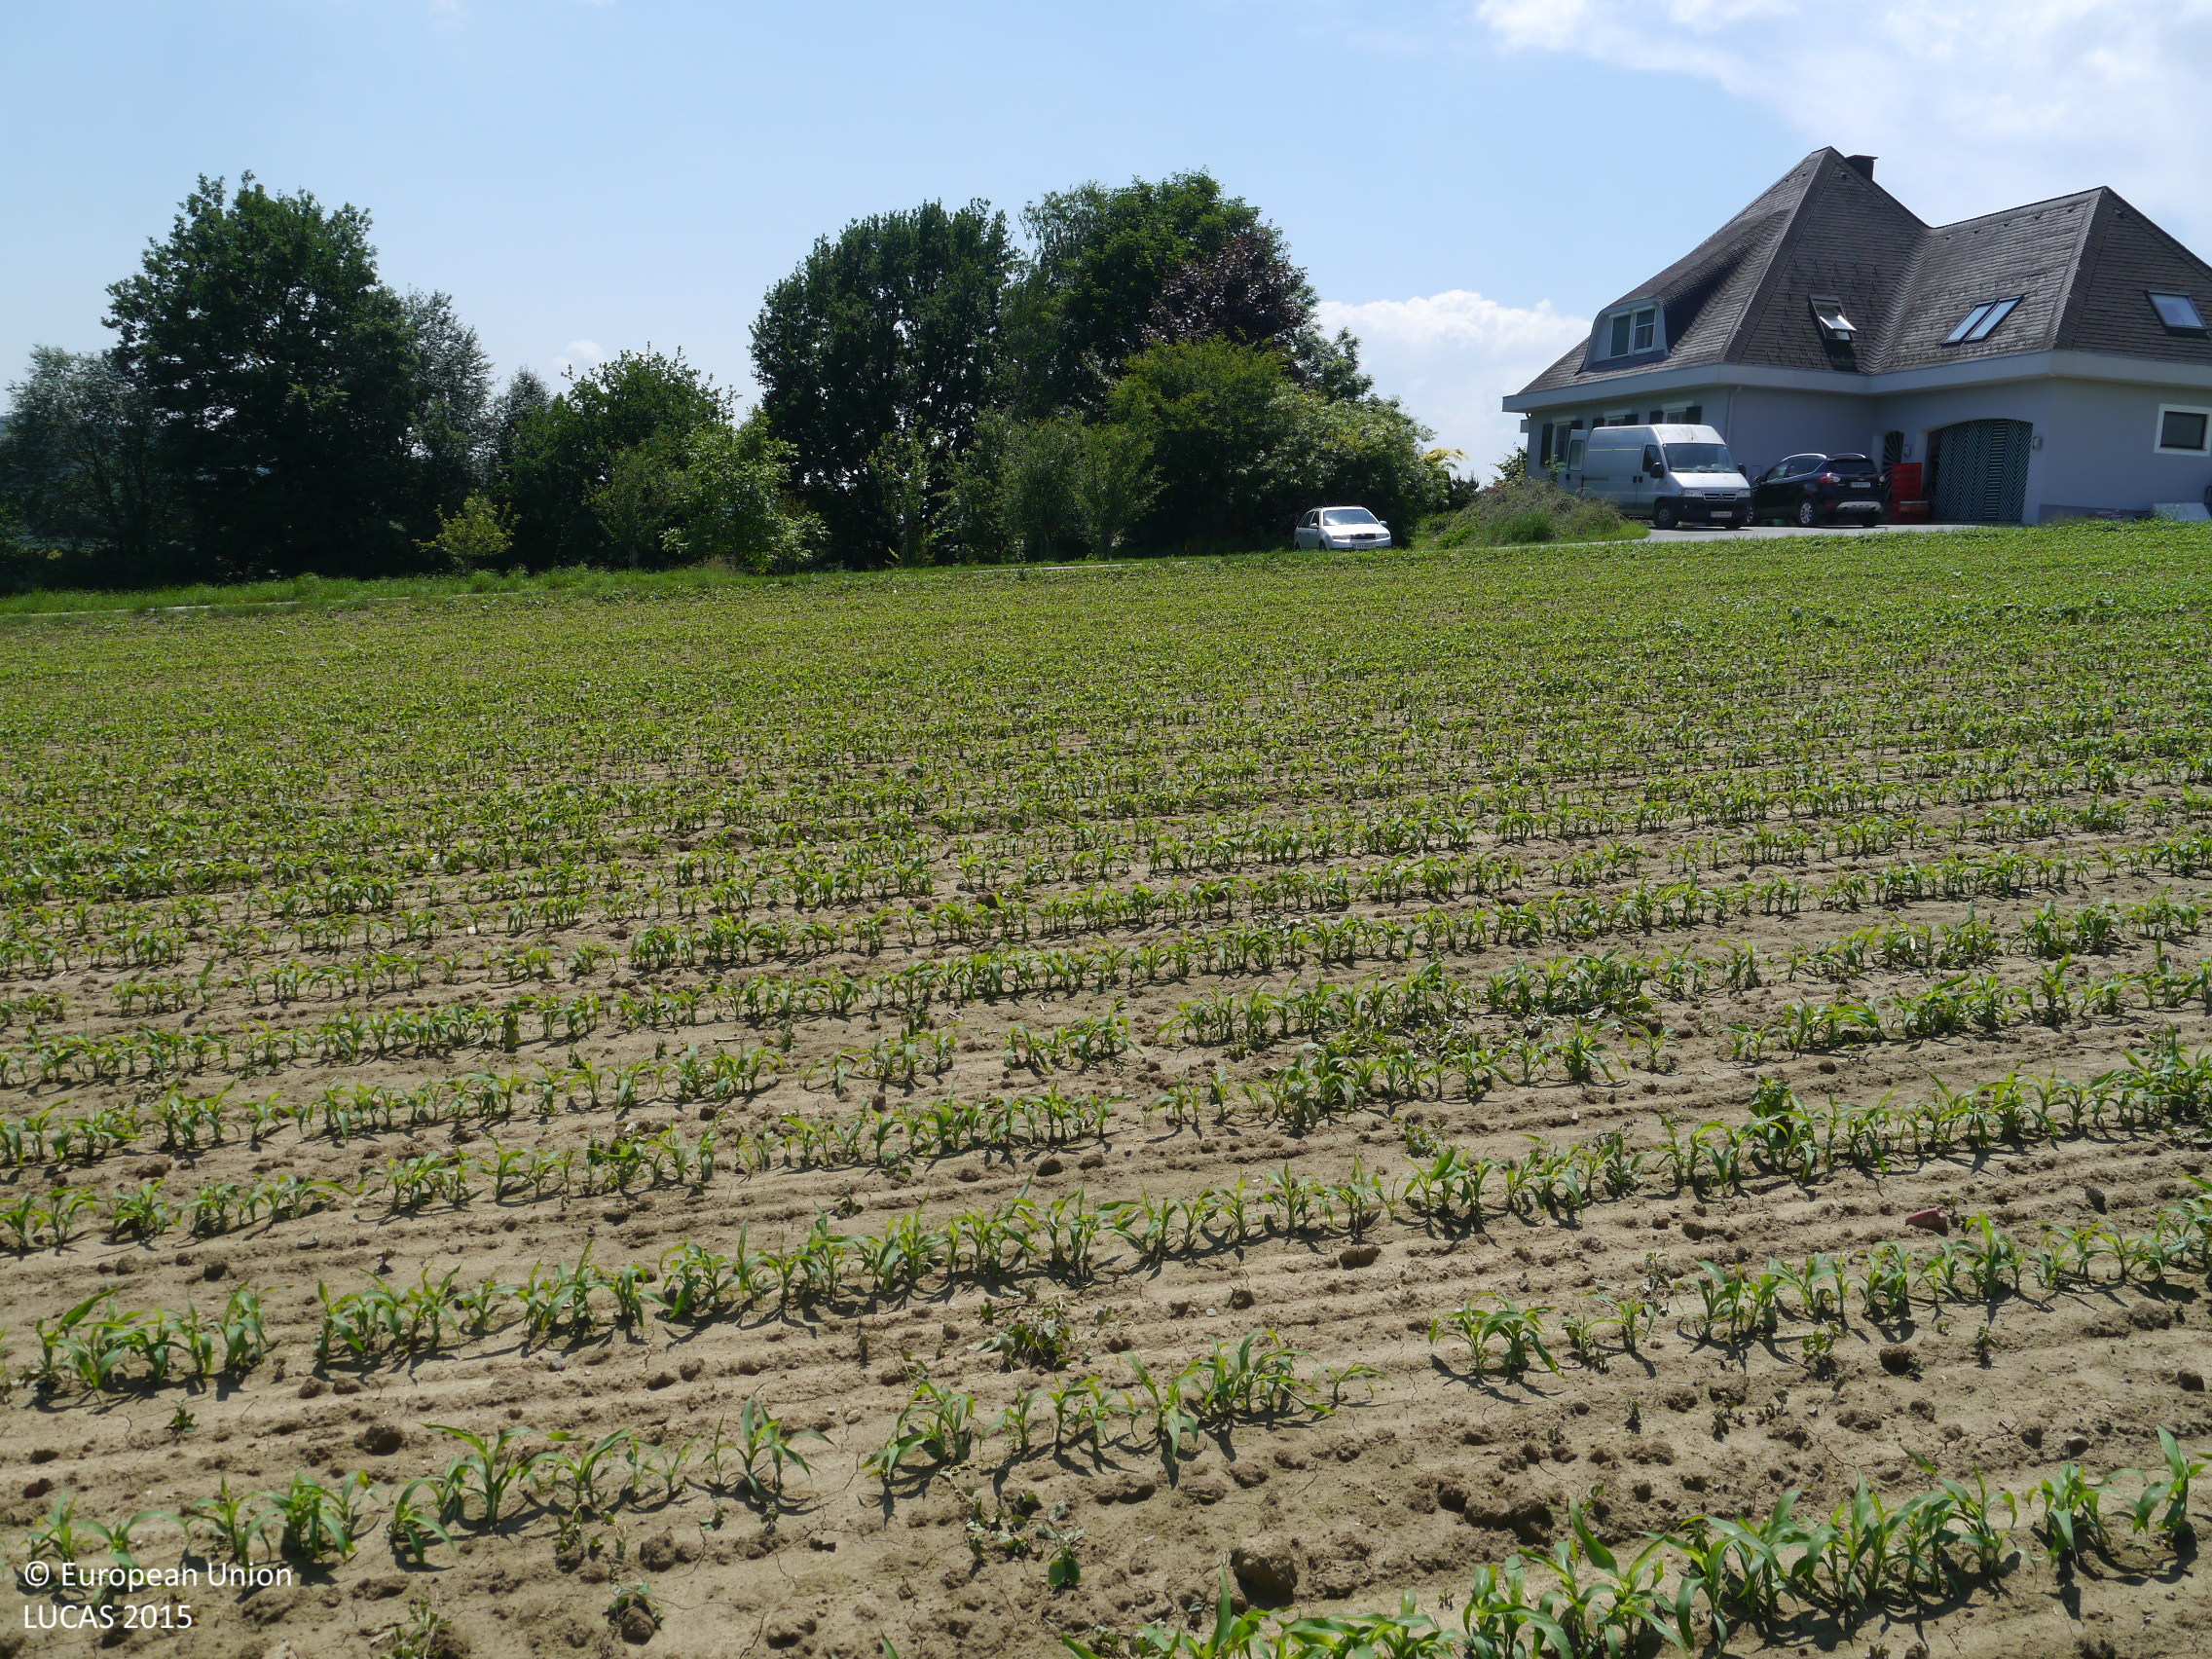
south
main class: Cropland
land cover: Maize
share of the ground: 25 - 50 %
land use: Agriculture (excluding fallow land and kitchen gardens)
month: June
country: AT
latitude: 46.8696
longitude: 15.6543
